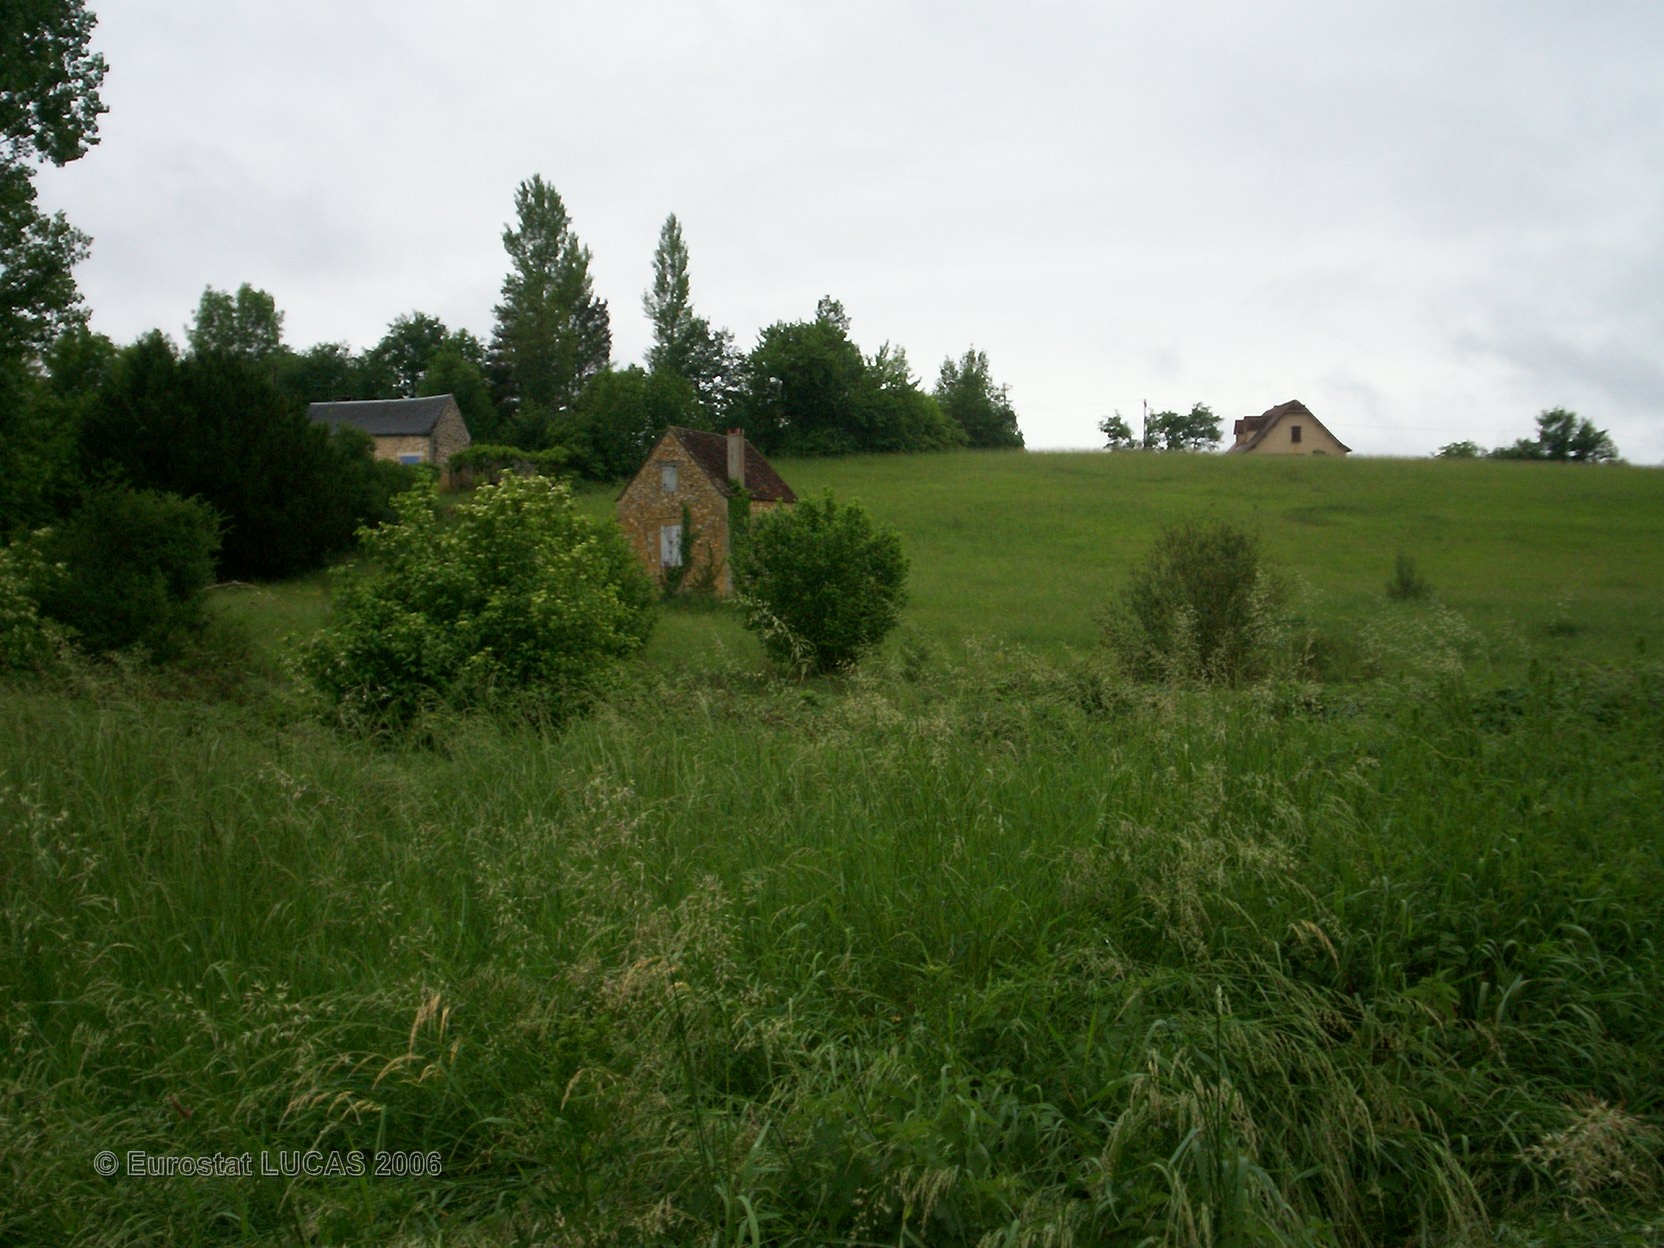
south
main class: Grassland
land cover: Grassland with sparse tree/shrub cover
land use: Agriculture (excluding fallow land and kitchen gardens)
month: May
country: FR
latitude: 44.7339
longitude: 1.3718
